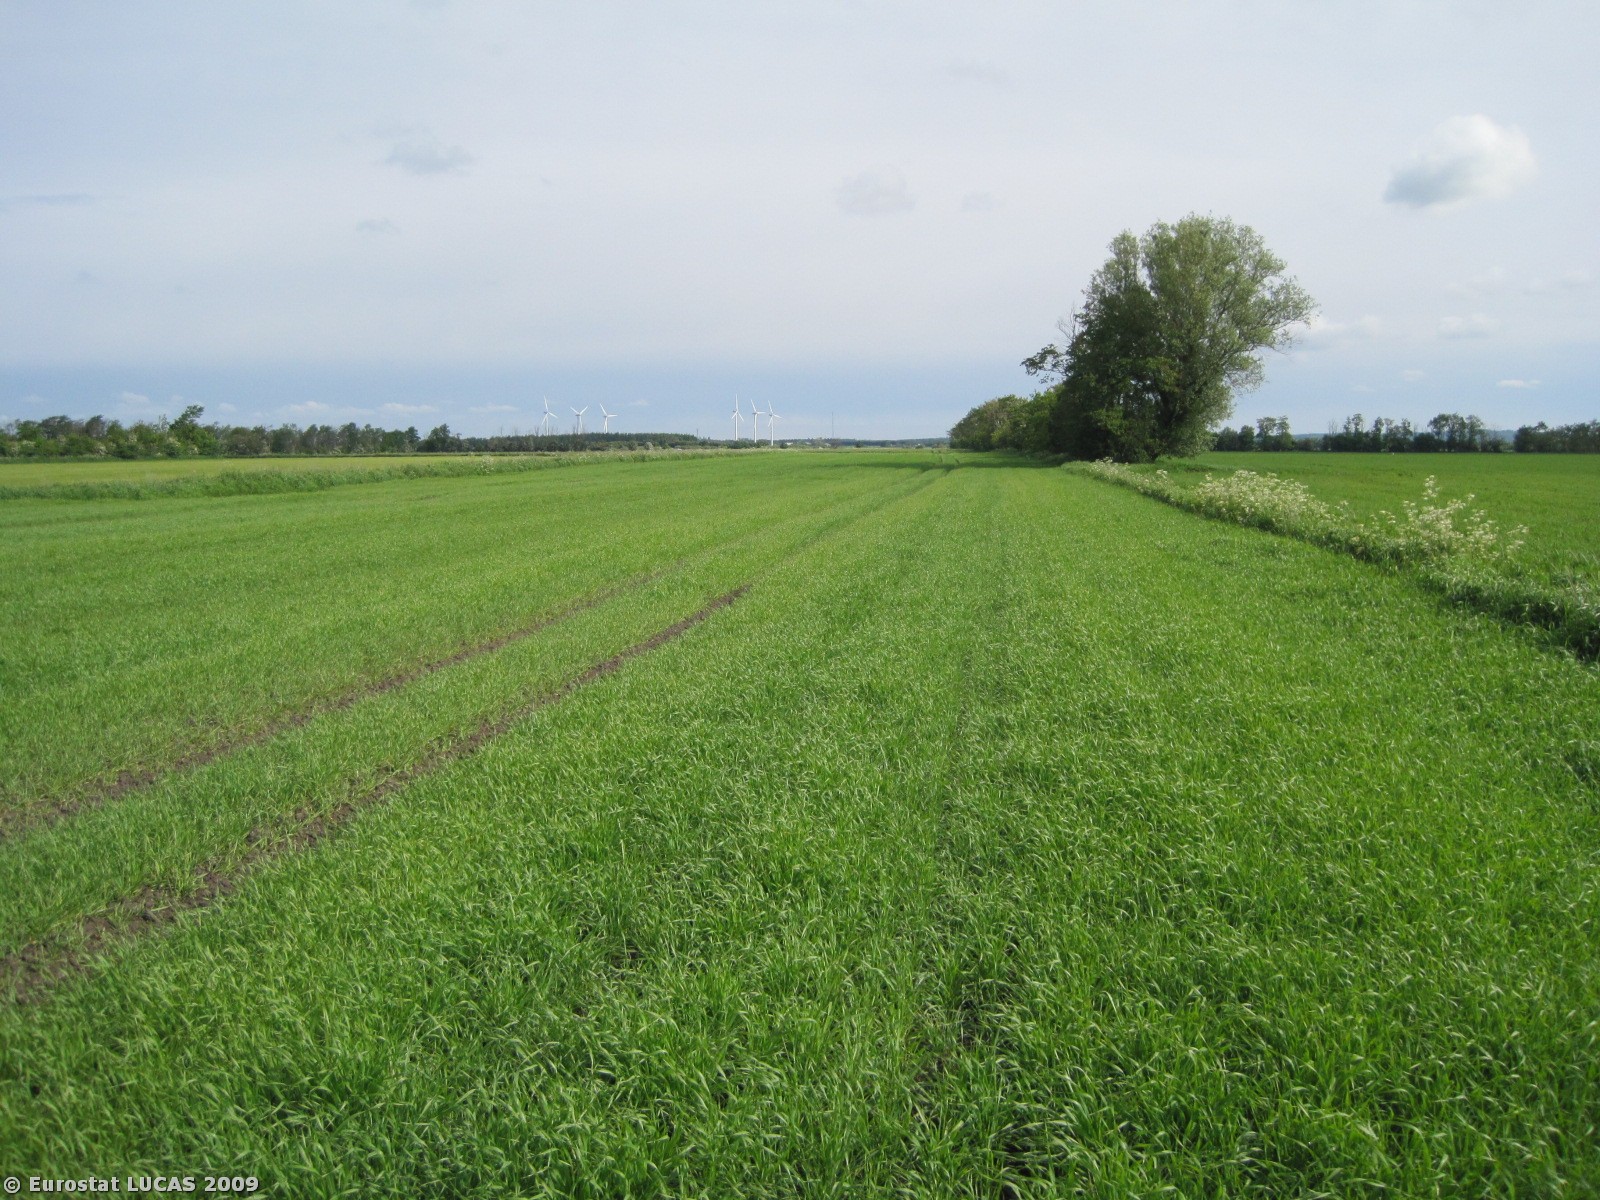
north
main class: Cropland
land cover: Barley
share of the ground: > 75 %
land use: Agriculture (excluding fallow land and kitchen gardens)
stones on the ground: < 10 %
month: June
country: DK
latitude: 57.1044
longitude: 10.2143
